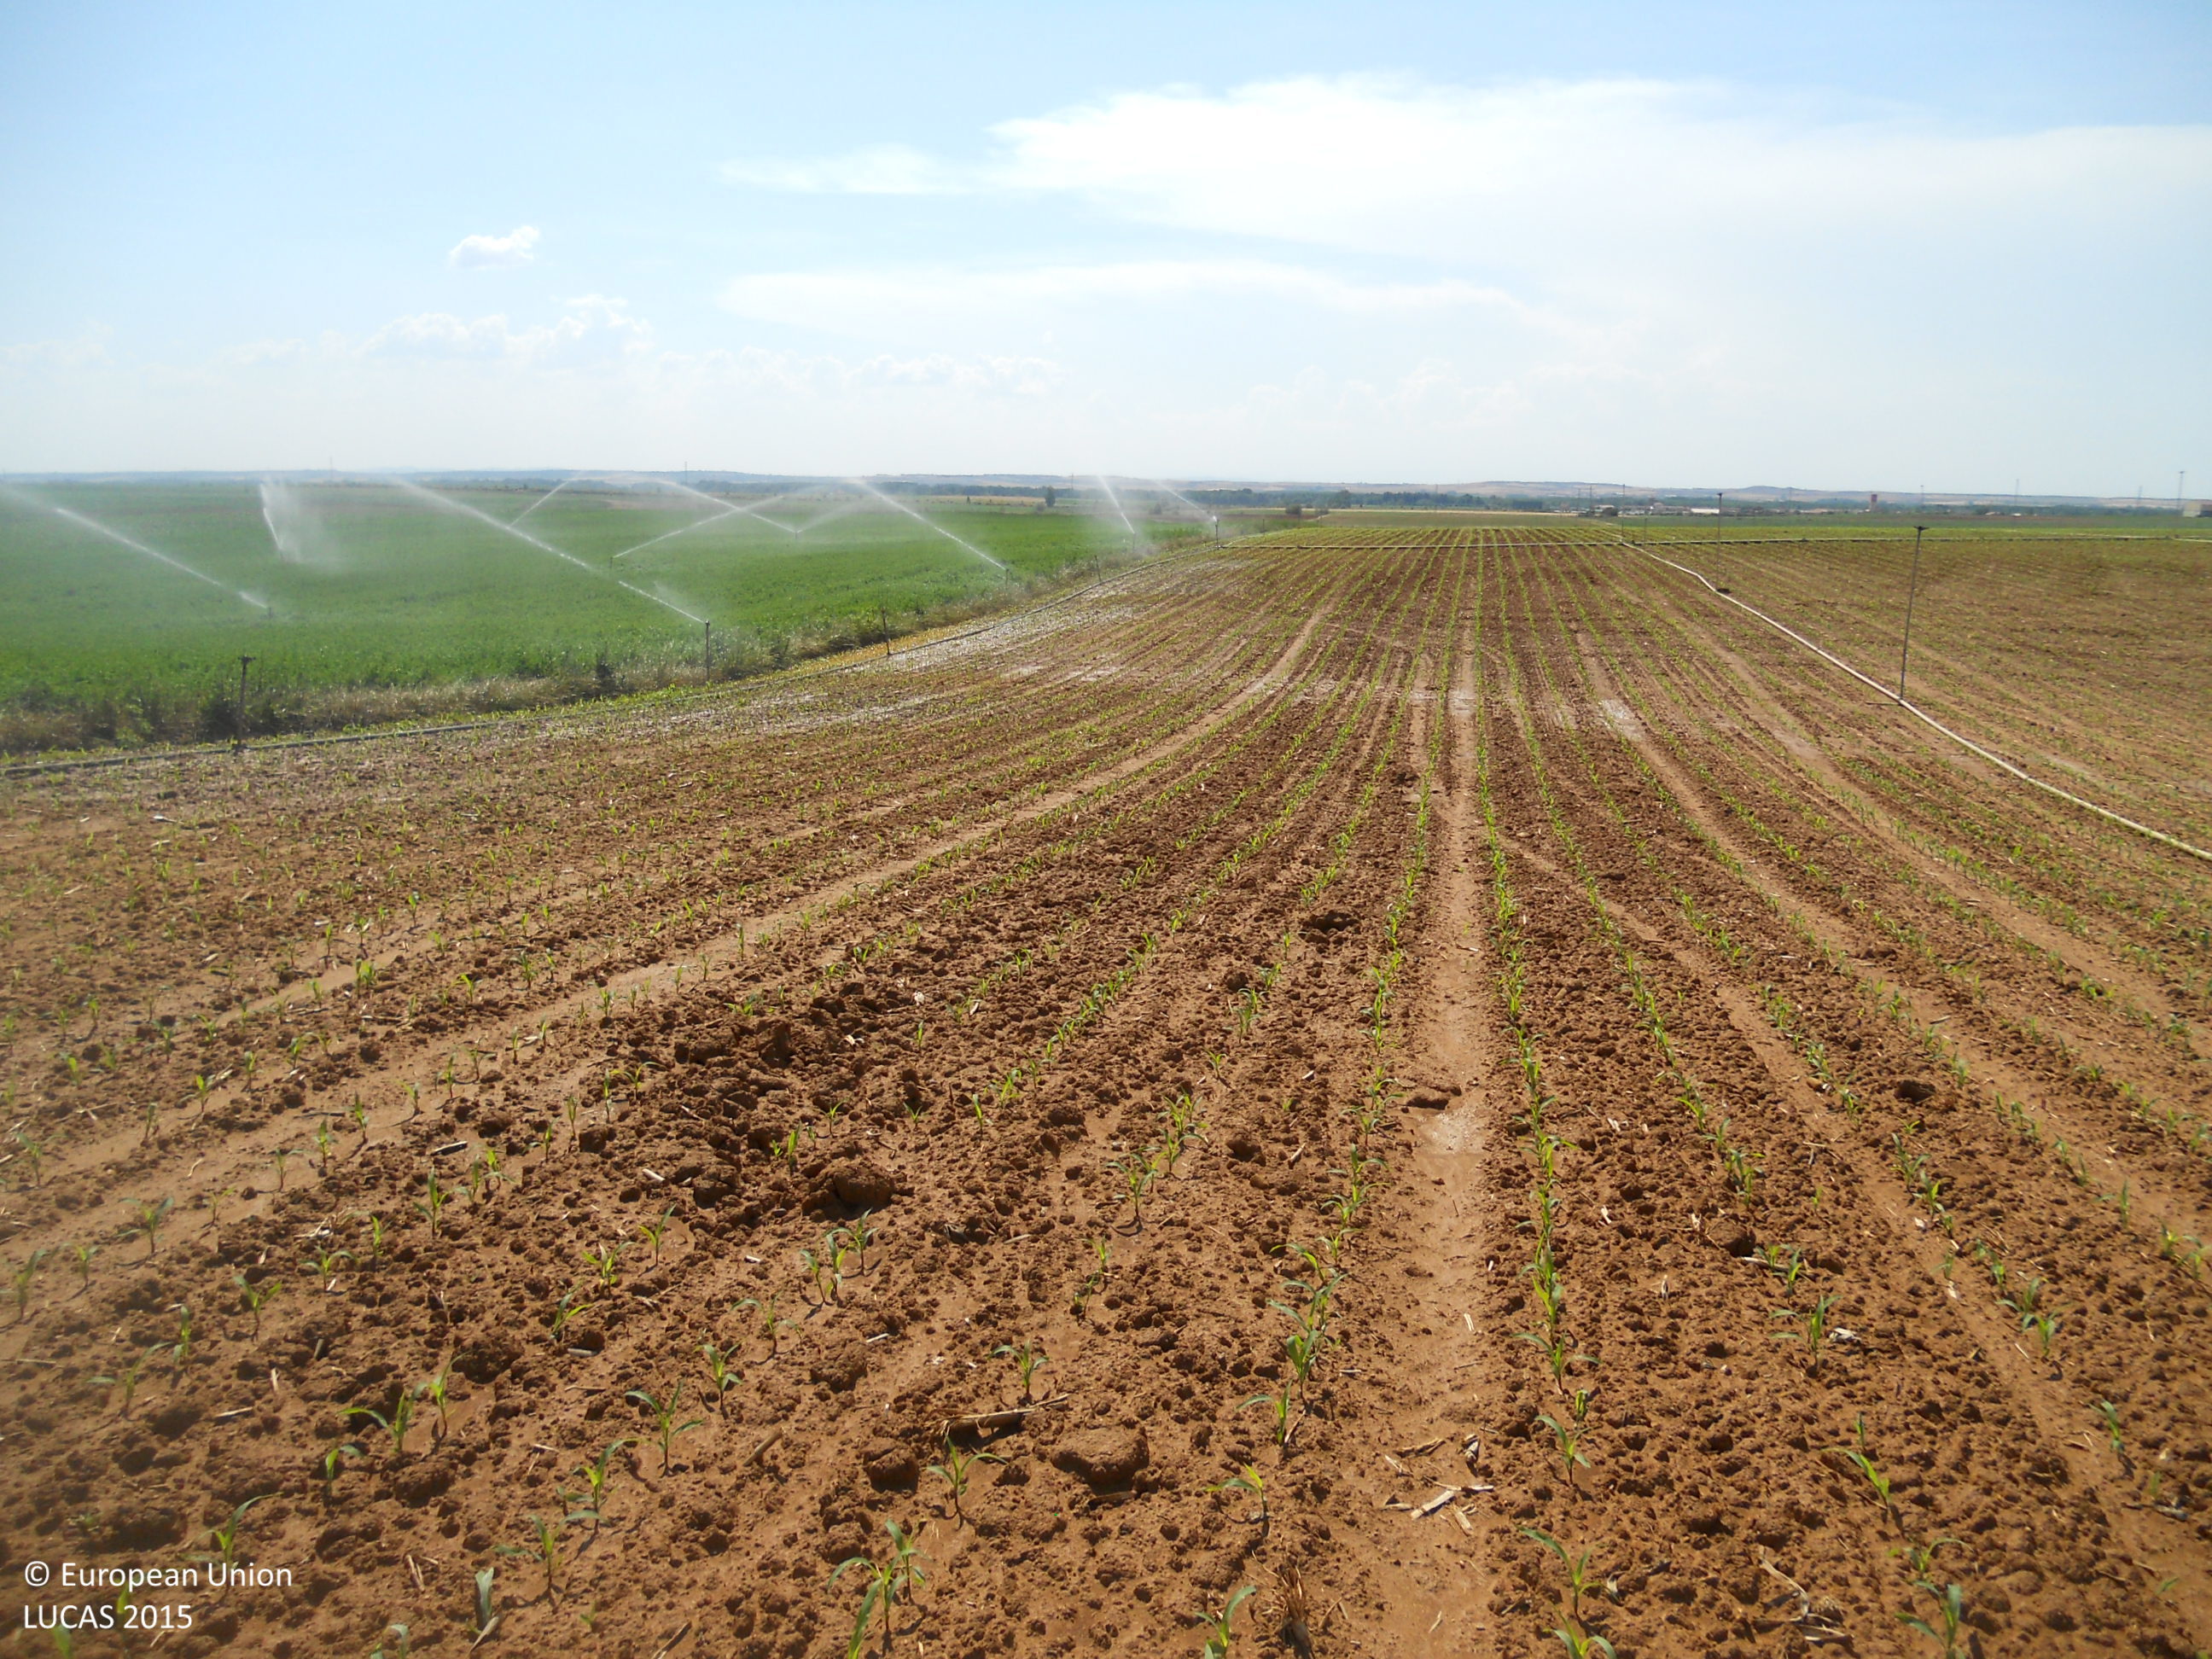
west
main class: Cropland
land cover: Maize
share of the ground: < 10 %
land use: Agriculture (excluding fallow land and kitchen gardens)
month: June
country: ES
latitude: 42.2036
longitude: -5.5088
